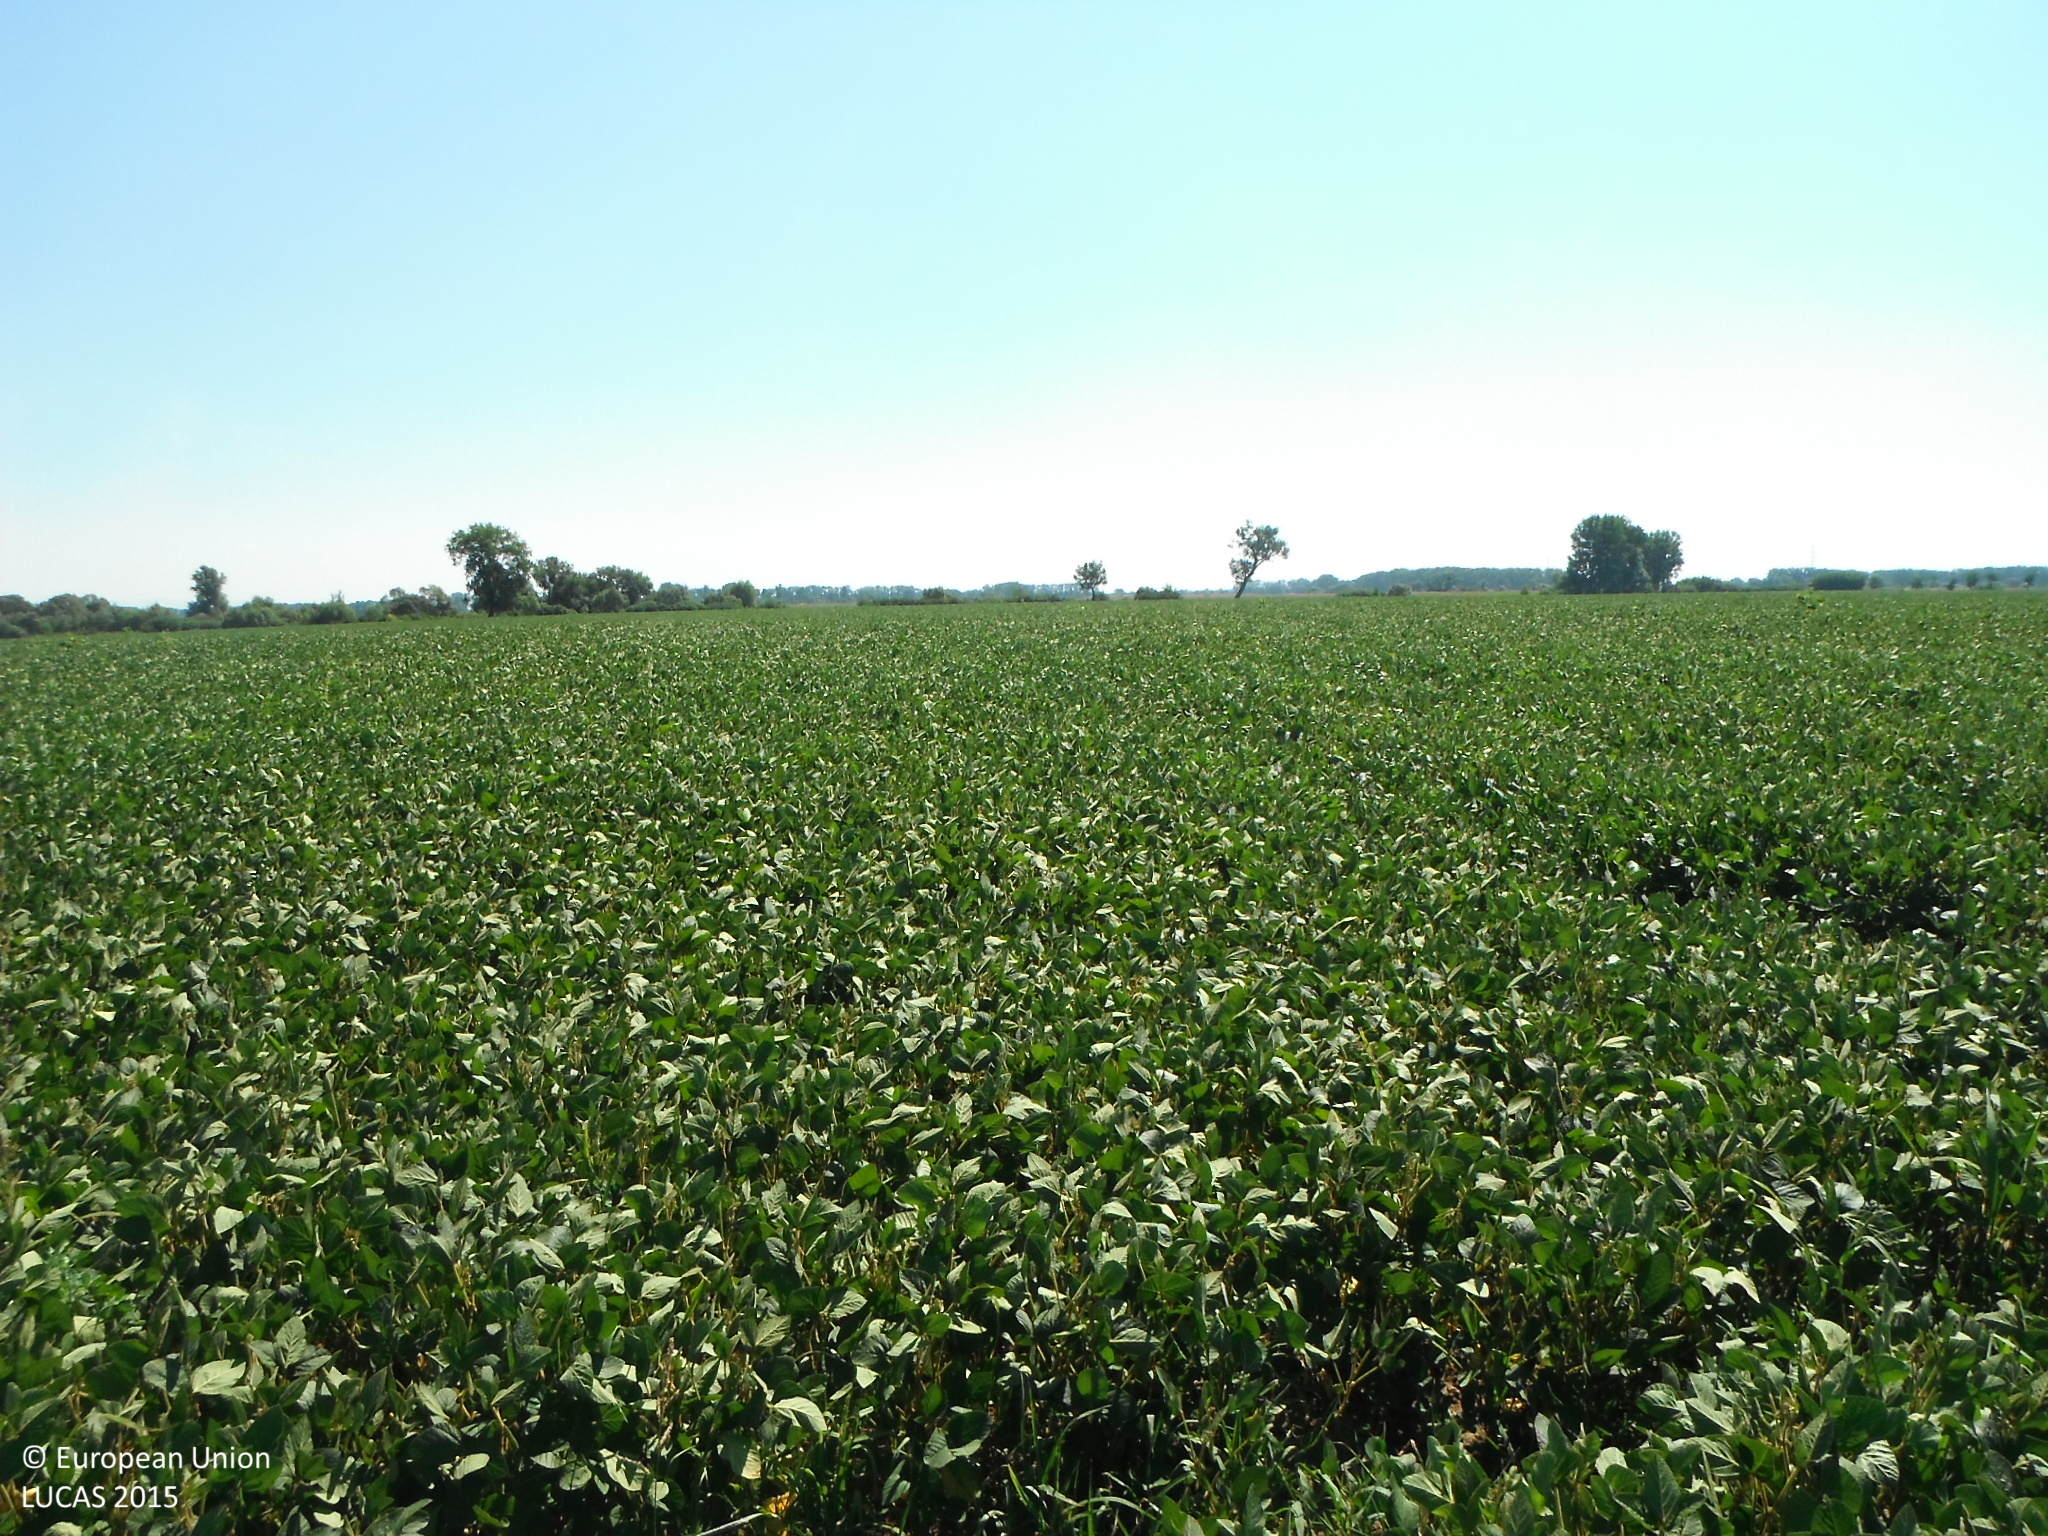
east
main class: Cropland
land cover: Soya
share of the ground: > 75 %
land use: Agriculture (excluding fallow land and kitchen gardens)
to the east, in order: Soya
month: July
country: SK
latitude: 48.6102
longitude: 21.7559
